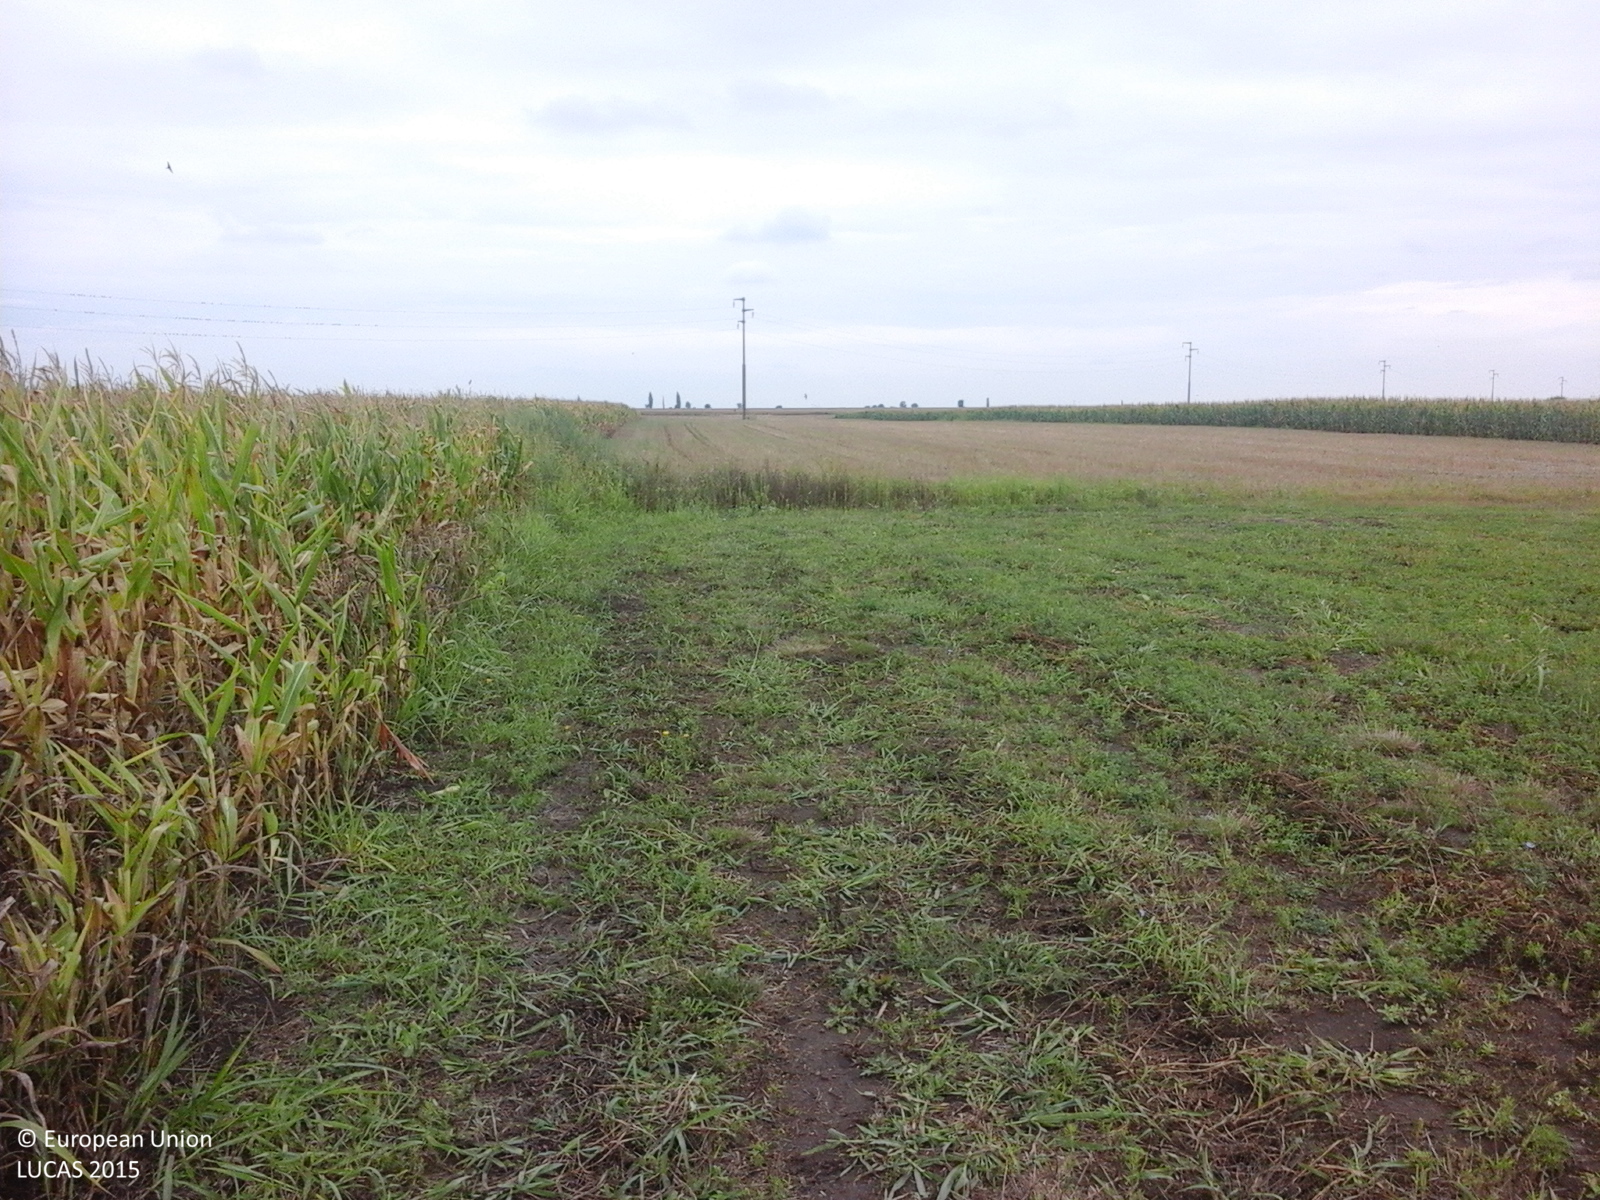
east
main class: Cropland
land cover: Maize
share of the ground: > 75 %
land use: Agriculture (excluding fallow land and kitchen gardens)
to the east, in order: Maize; Electric lines; Maize
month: August
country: RO
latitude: 45.9456
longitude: 20.8243
